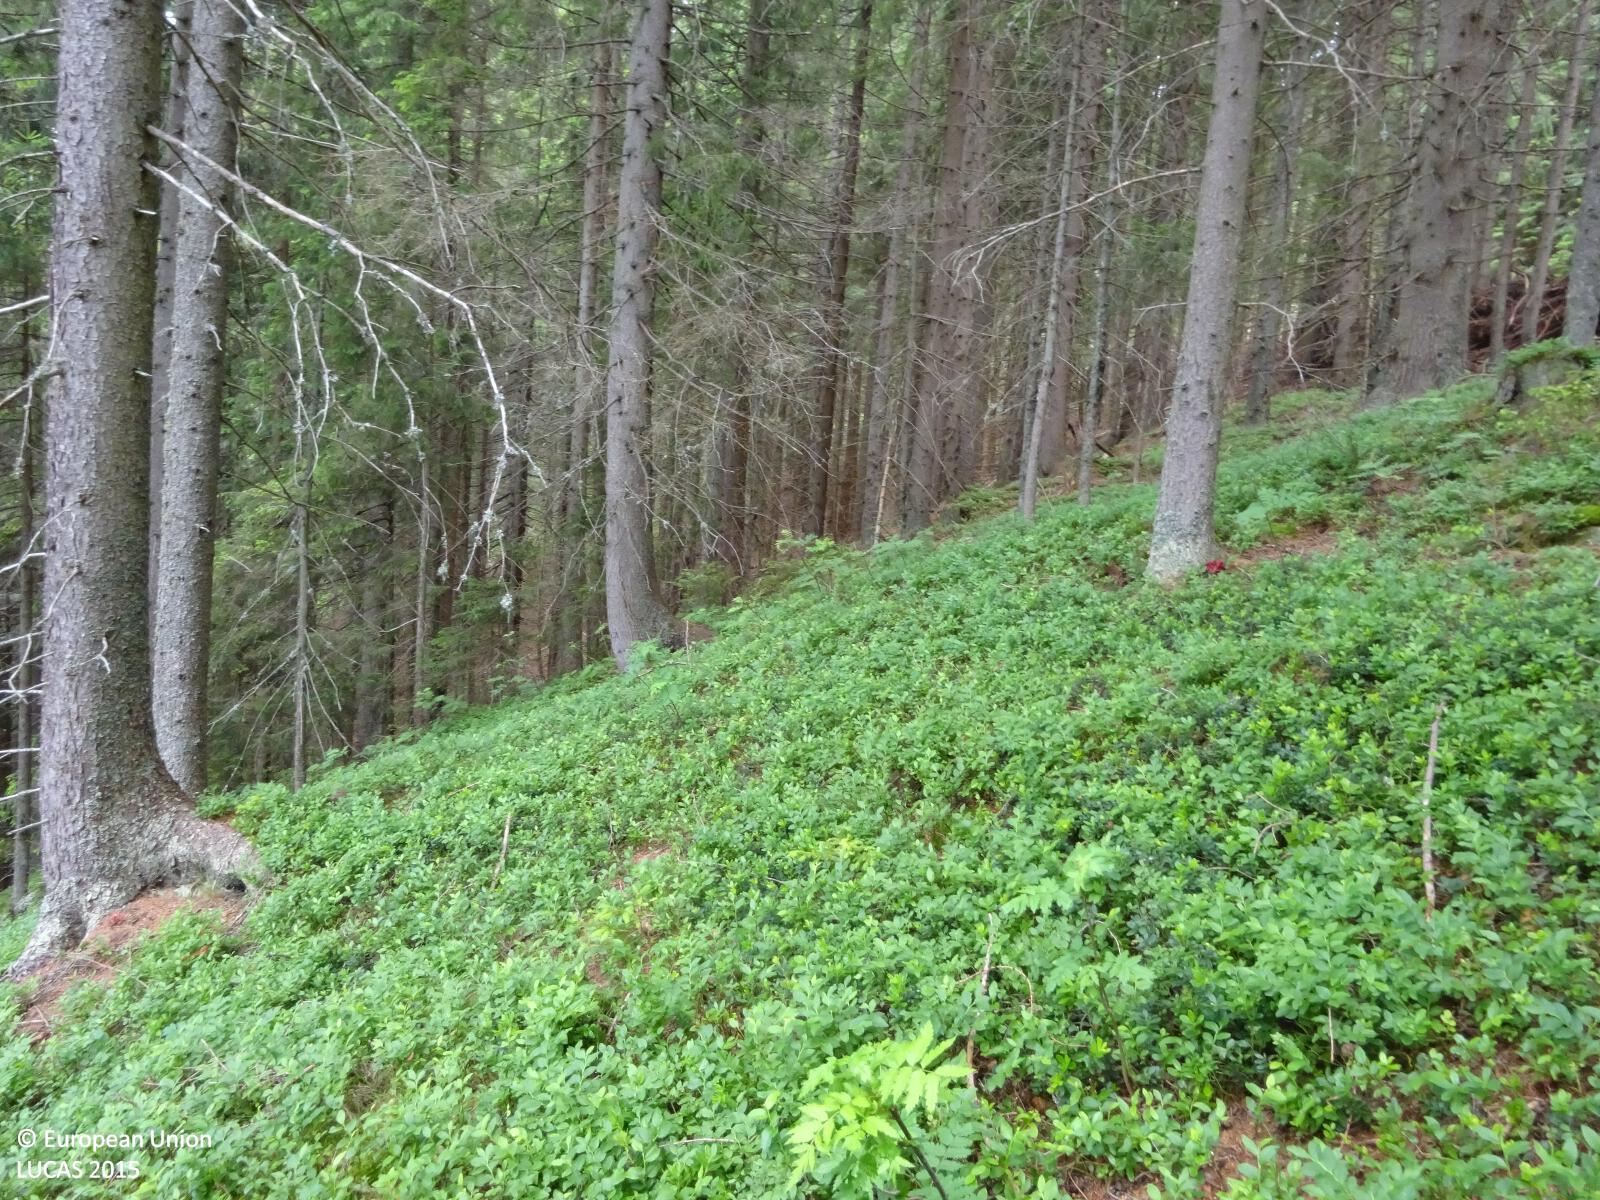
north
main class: Woodland
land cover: Spruce dominated coniferous woodland
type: alpine coniferous forest
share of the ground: > 75 %
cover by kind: coniferous forest trees 85 %, shrubs 10 %, herbaceous plants 5 %
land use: Forestry
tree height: > 5 m
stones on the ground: < 10 %
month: June
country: AT
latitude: 47.5859
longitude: 15.7593
